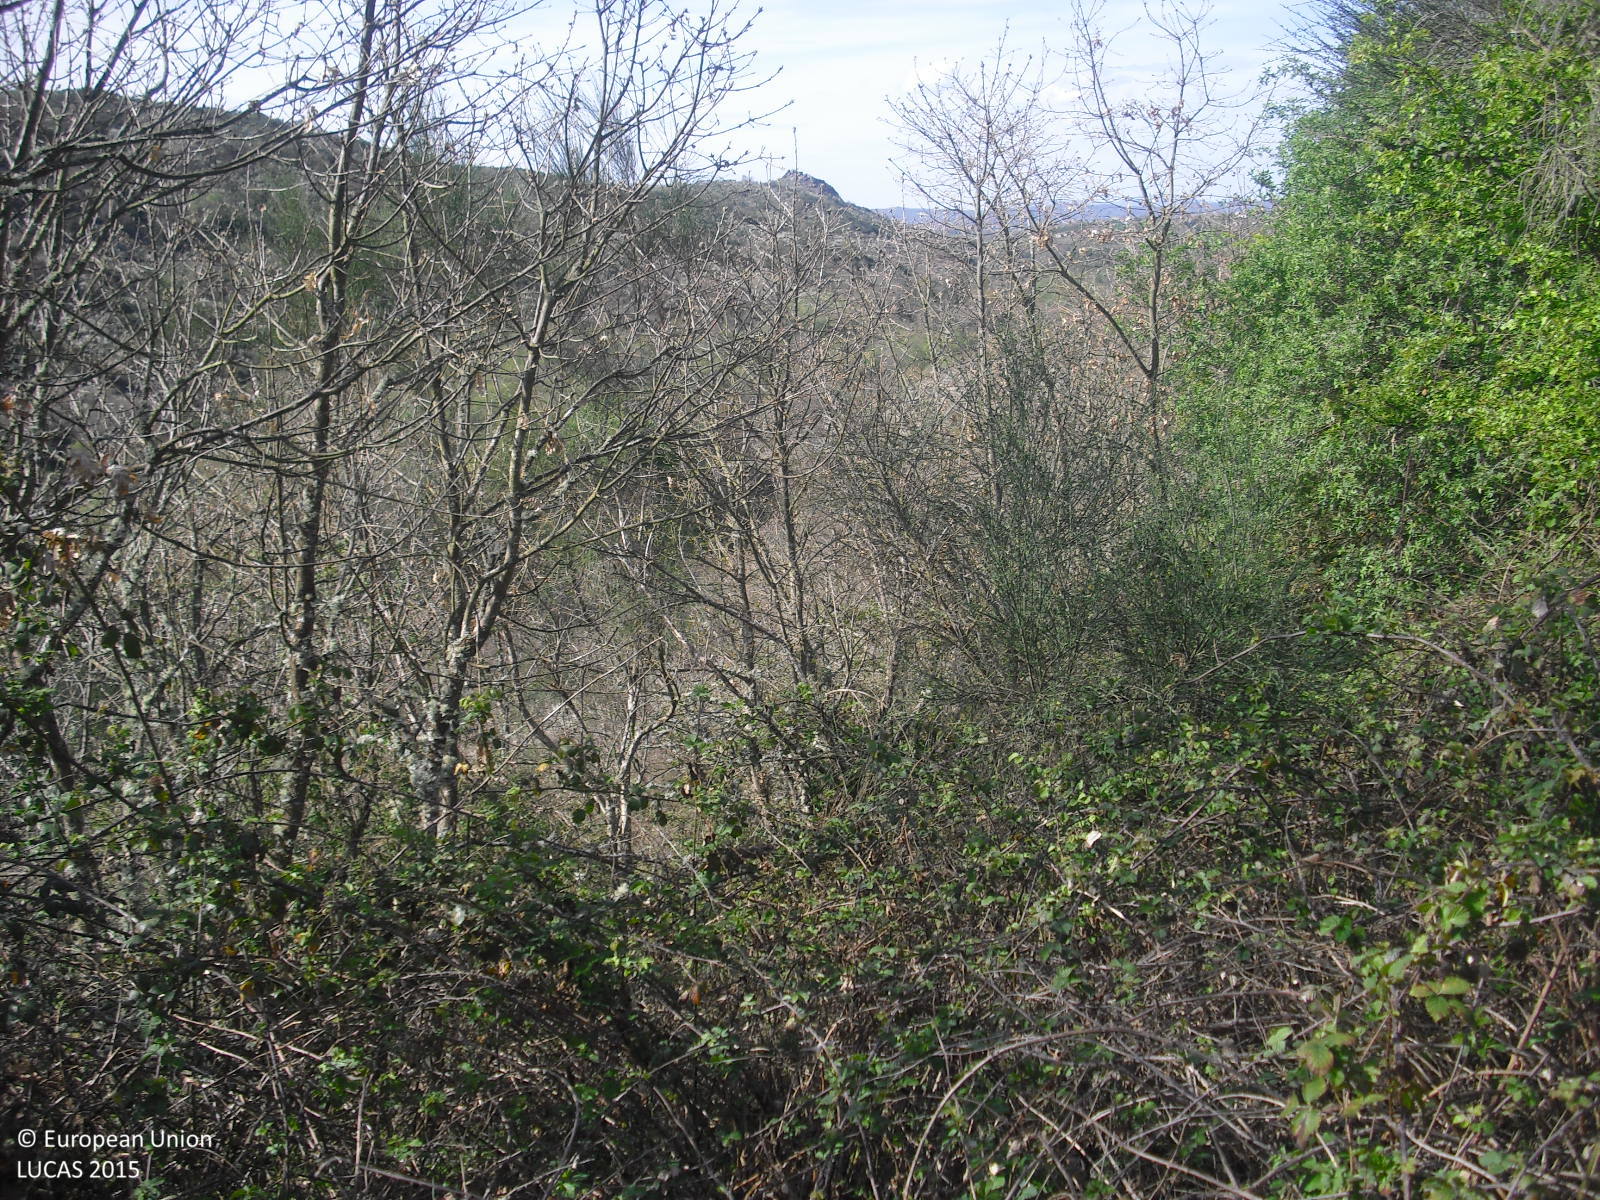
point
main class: Woodland
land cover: Broadleaved woodland
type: thermophilous deciduous forest
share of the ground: 50 - 75 %
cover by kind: broadleaved forest trees 60 %, shrubs 30 %, herbaceous plants 10 %
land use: Semi-natural and natural areas not in use
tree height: < 5 m
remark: Burnt area
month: April
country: ES
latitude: 41.9924
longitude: -7.6545
